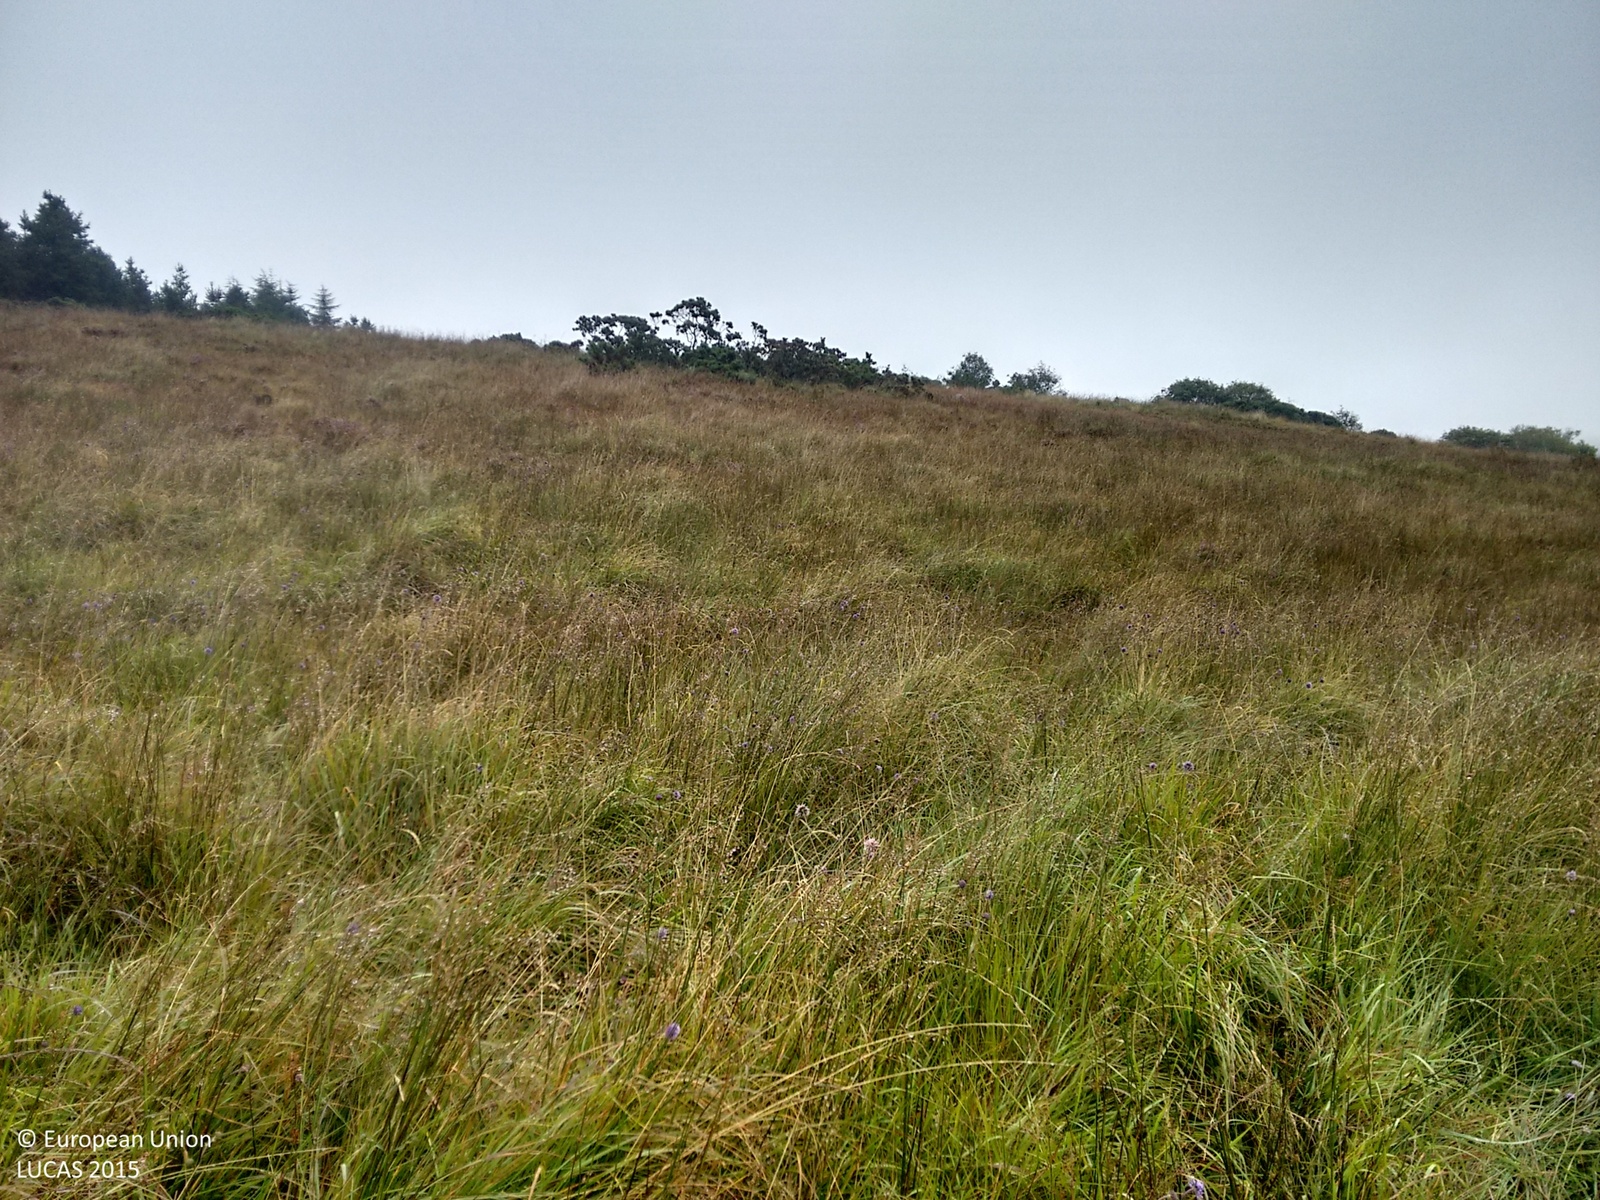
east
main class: Grassland
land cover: Grassland without tree/shrub cover
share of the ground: > 75 %
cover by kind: herbaceous plants 100 %
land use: Agriculture (excluding fallow land and kitchen gardens)
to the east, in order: Grassland without tree/shrub cover; Single bushes/trees; Grassland without tree/shrub cover; Shrubland with sparse tree cover; Grassland without tree/shrub cover; Abandoned hedges; Grassland without tree/shrub cover; Abandoned hedges; Fences; Grassland without tree/shrub cover; Shrubland with sparse tree cover; Grassland without tree/shrub cover
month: September
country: IE
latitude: 52.7387
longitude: -8.7007
